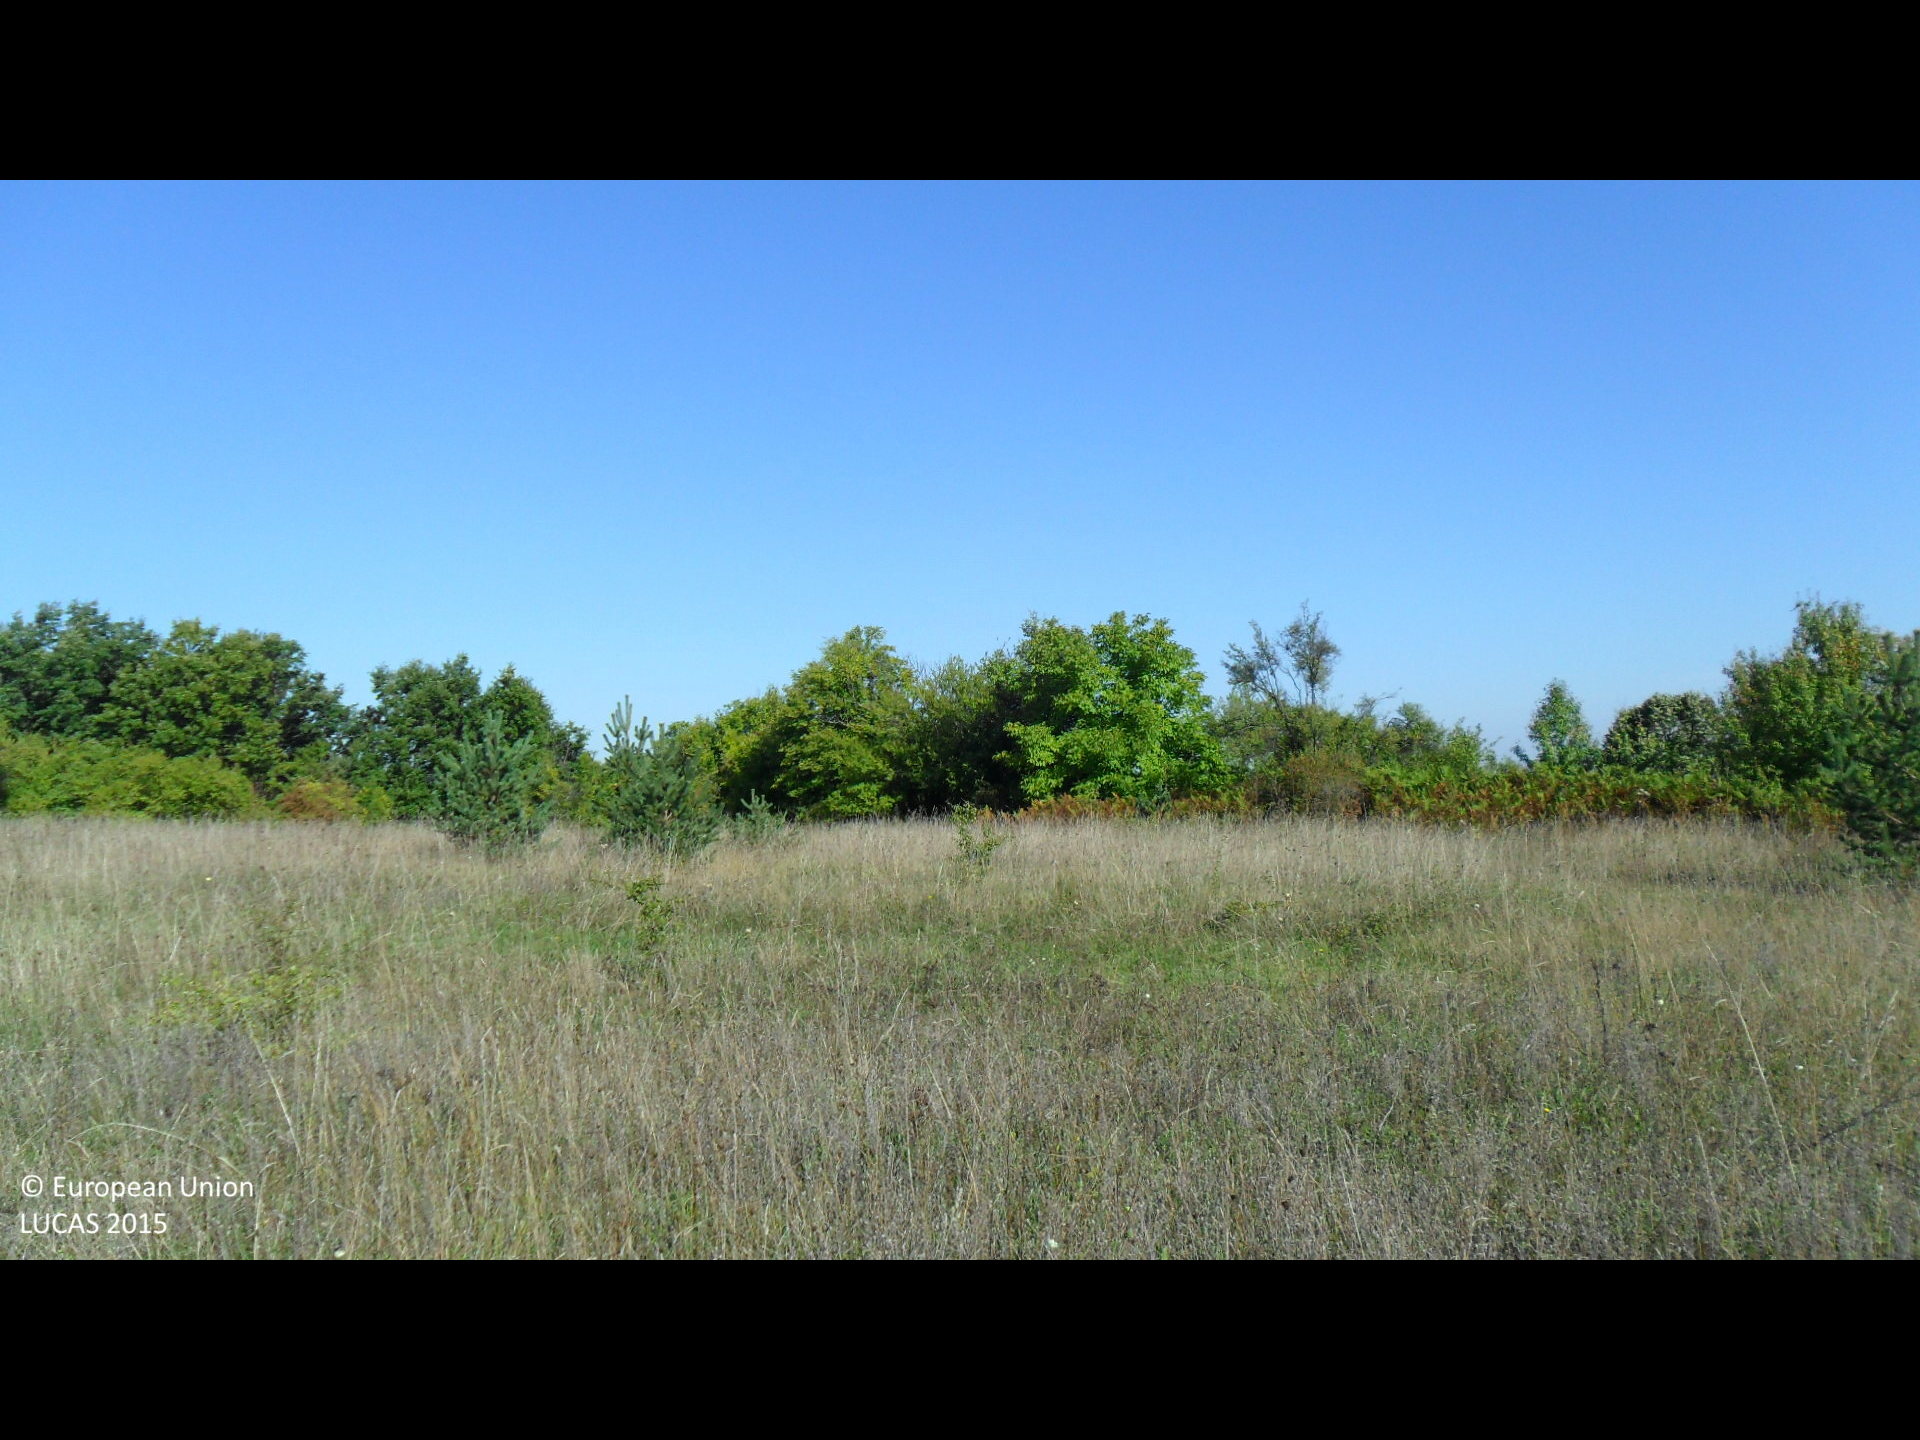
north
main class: Grassland
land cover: Grassland without tree/shrub cover
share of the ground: > 75 %
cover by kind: herbaceous plants 100 %
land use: Semi-natural and natural areas not in use
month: October
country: BG
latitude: 43.1703
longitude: 26.2455
